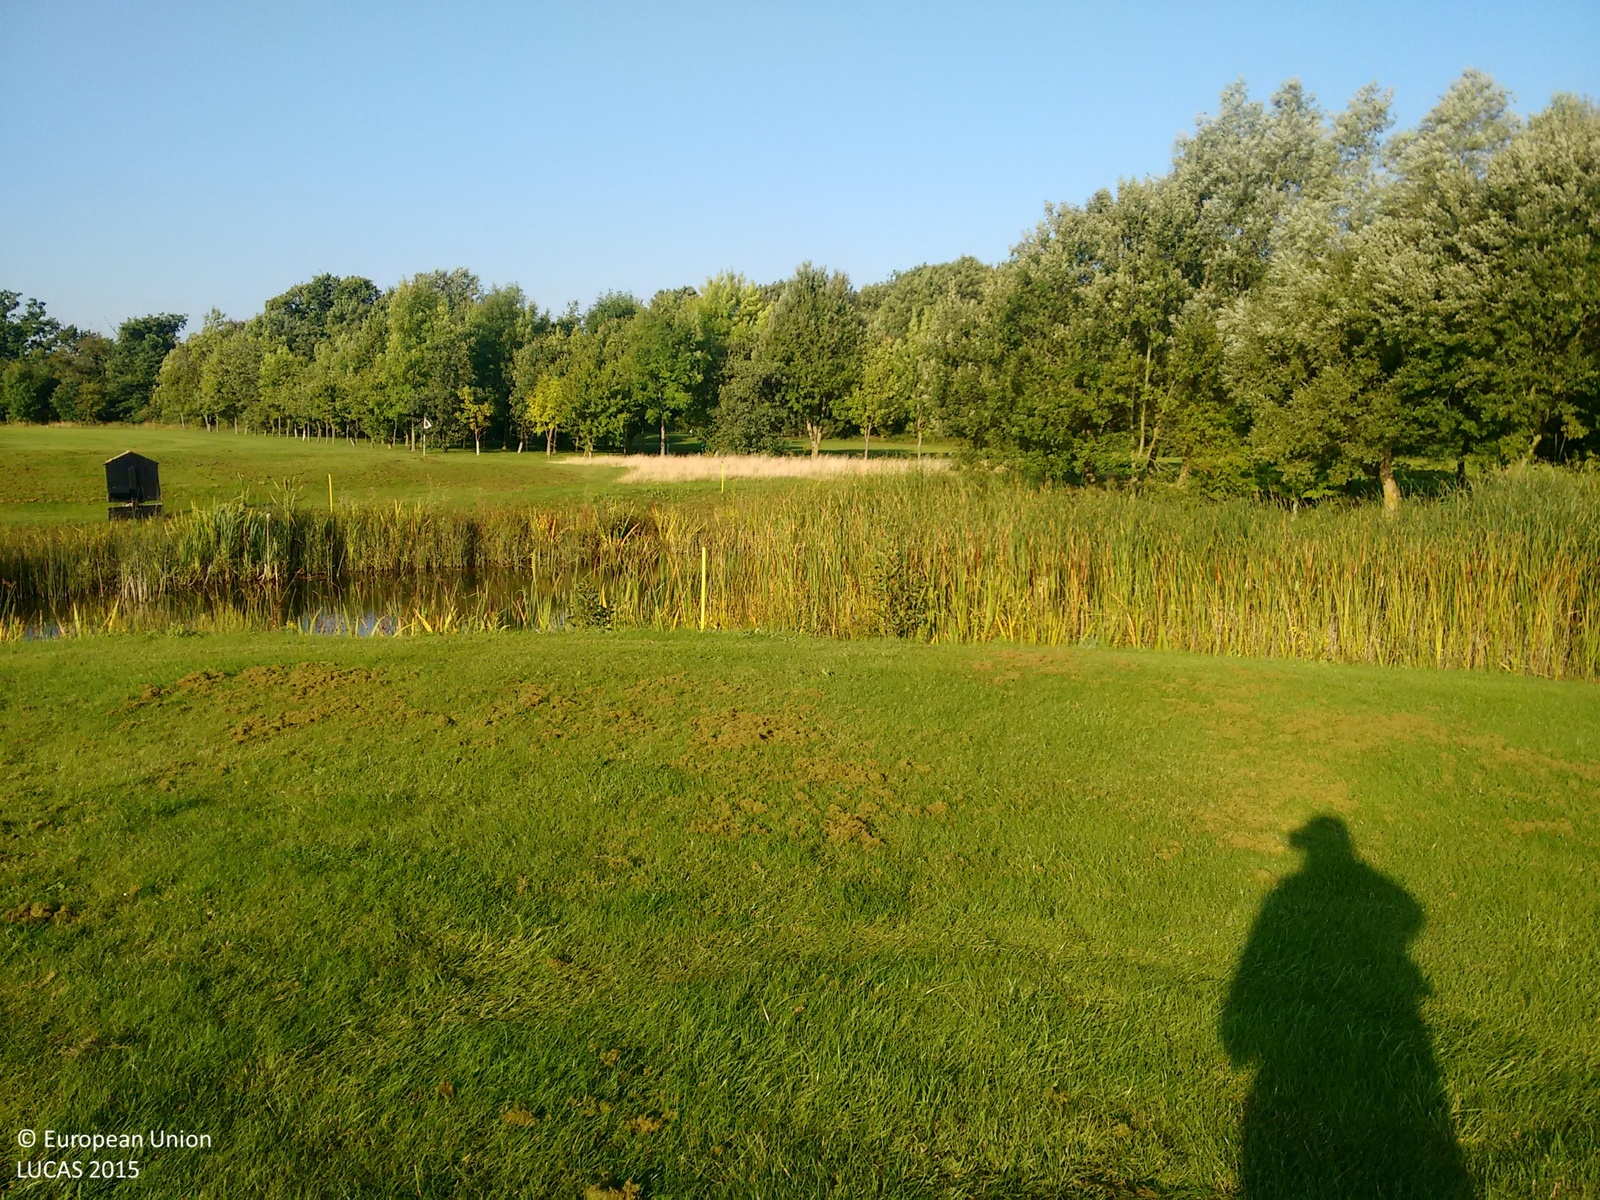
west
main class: Grassland
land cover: Grassland without tree/shrub cover
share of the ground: > 75 %
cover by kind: herbaceous plants 100 %
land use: Sport
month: September
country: GB
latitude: 52.2928
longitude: 1.5506
